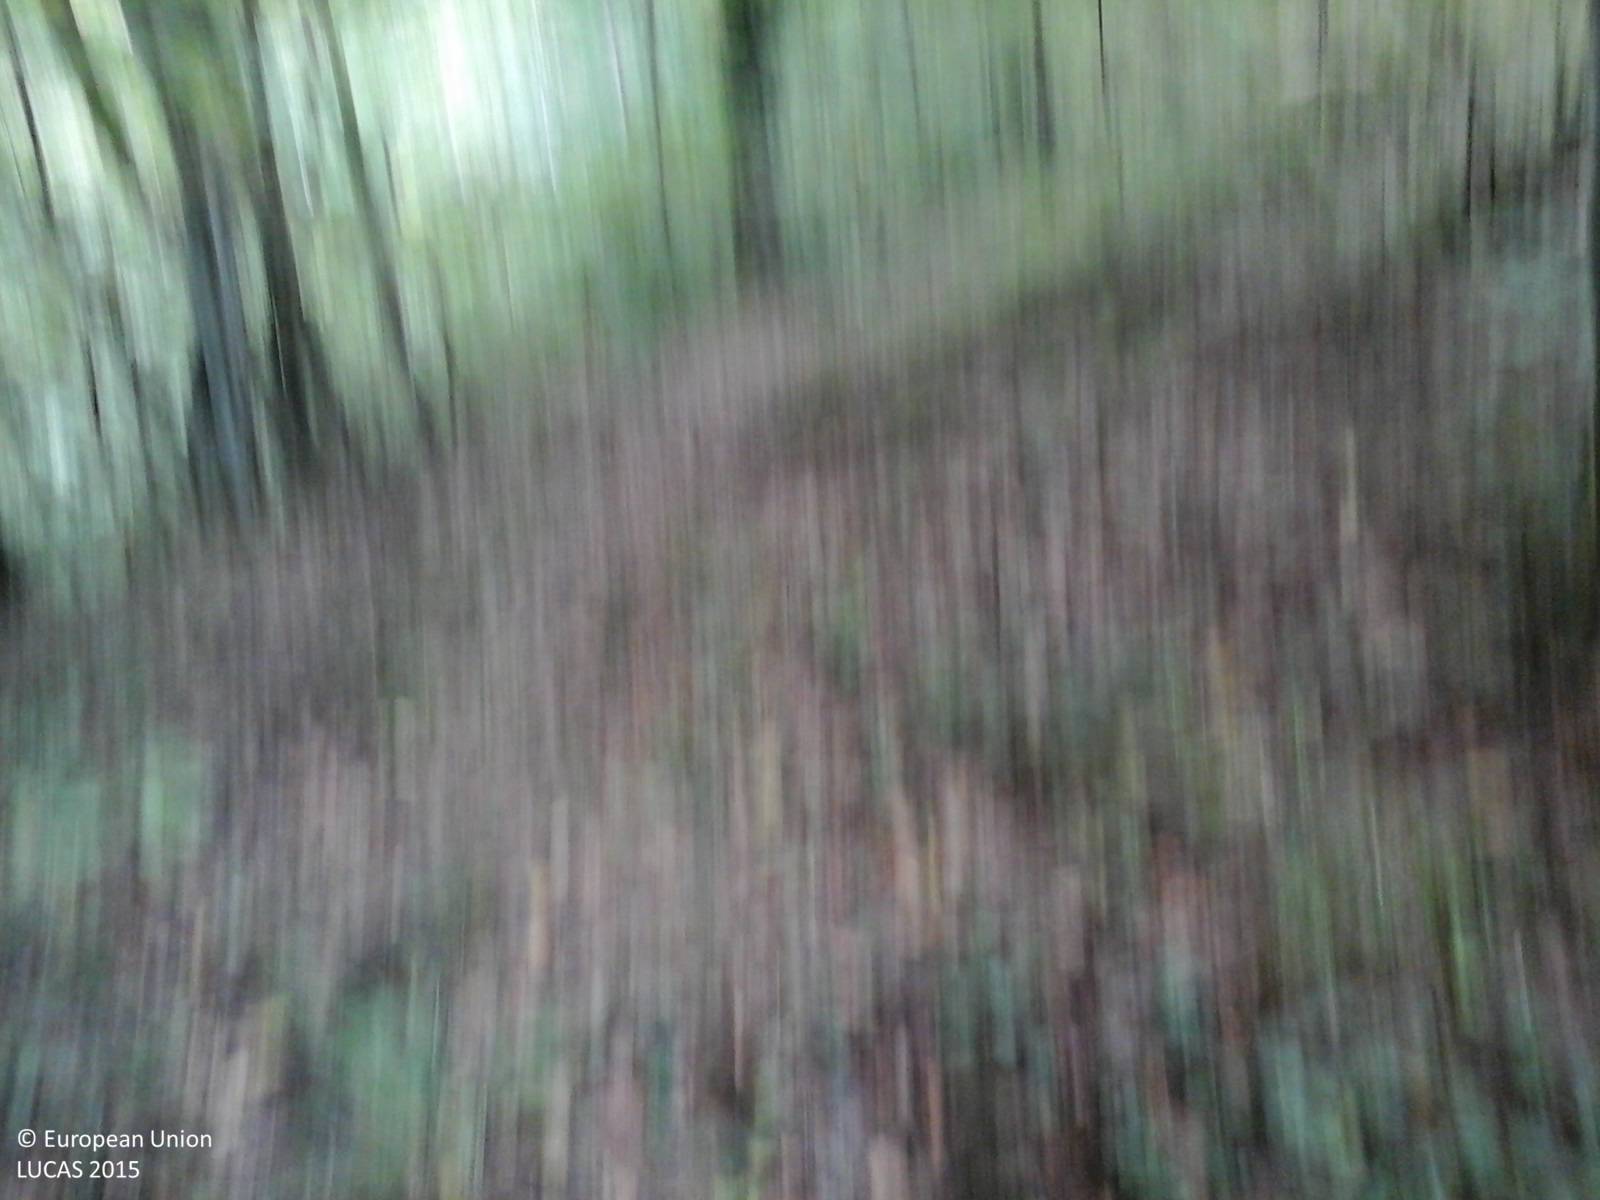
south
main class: Woodland
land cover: Broadleaved woodland
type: thermophilous deciduous forest
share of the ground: > 75 %
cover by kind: broadleaved forest trees 100 %
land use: Forestry
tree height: > 5 m
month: October
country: IT
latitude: 42.5142
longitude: 13.1667
